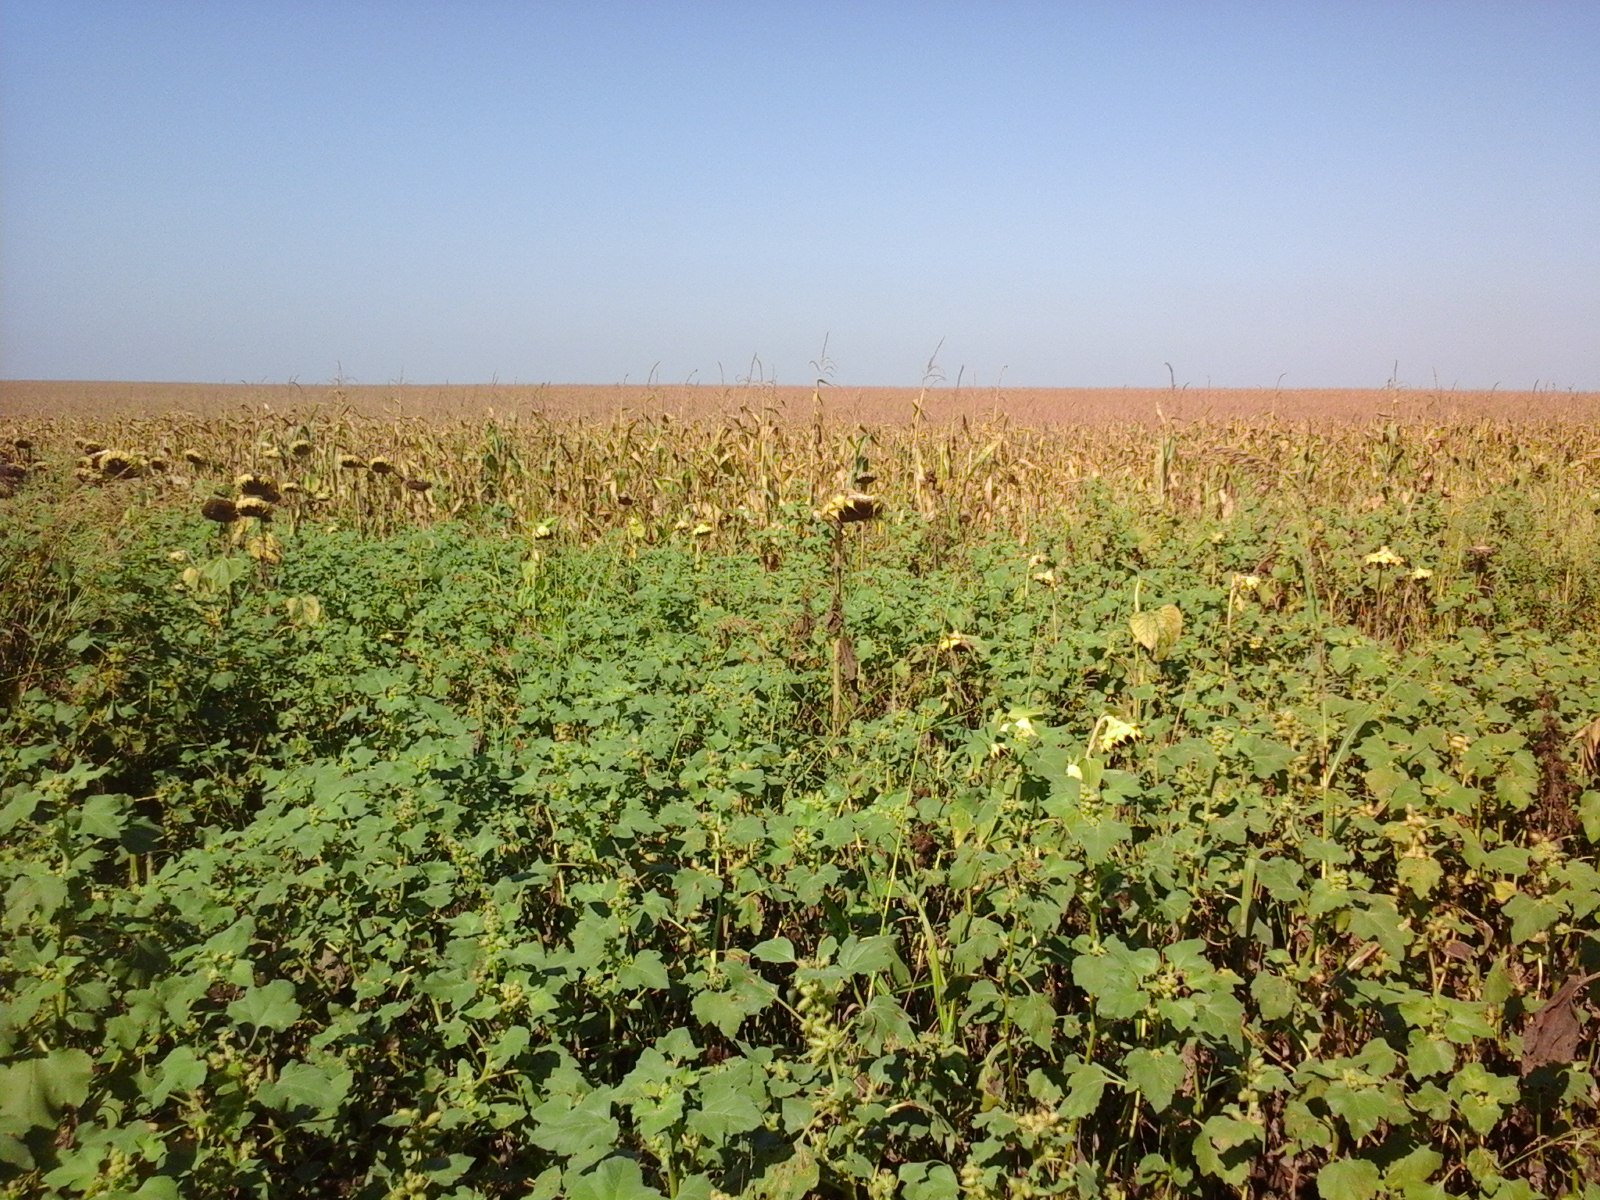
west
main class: Cropland
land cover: Sunflower
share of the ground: > 75 %
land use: Agriculture (excluding fallow land and kitchen gardens)
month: August
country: RO
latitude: 46.0721
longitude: 21.0067
